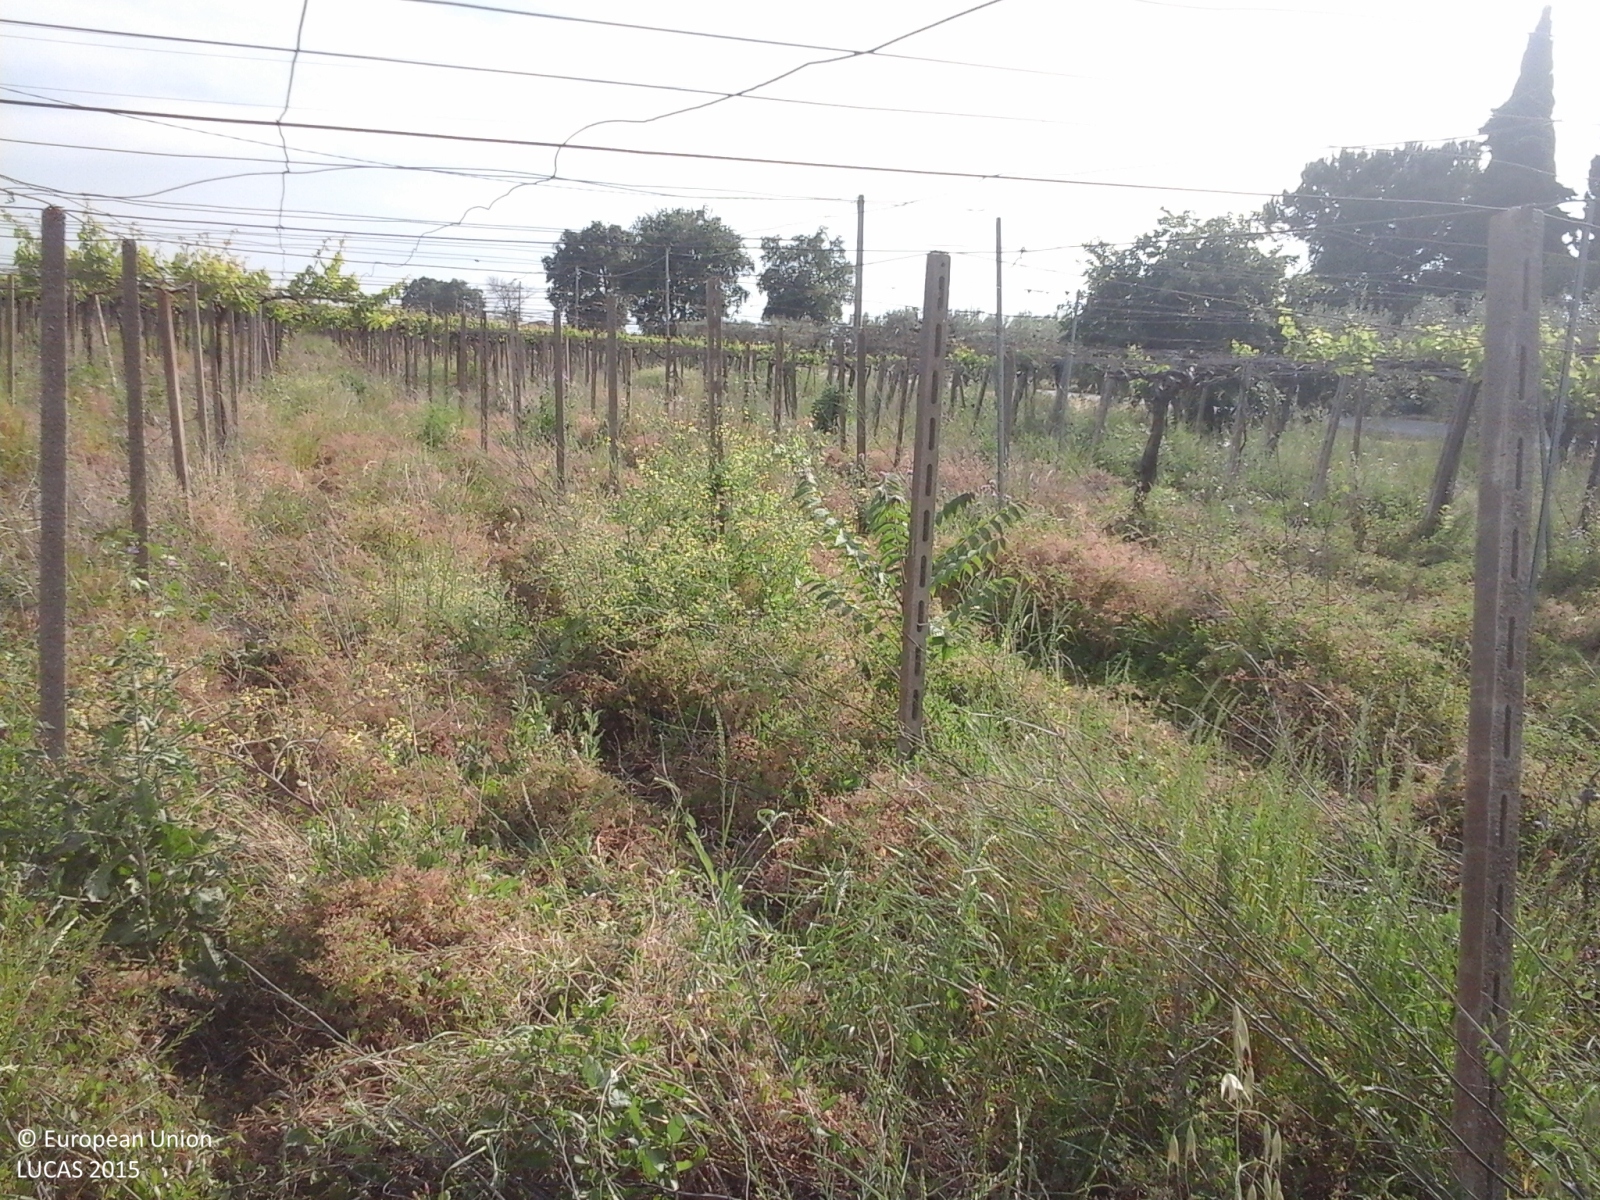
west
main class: Cropland
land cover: Vineyards
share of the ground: < 10 %
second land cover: Spontaneously vegetated surfaces
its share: > 75 %
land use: Abandoned areas
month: May
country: IT
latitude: 42.1867
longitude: 14.6235
